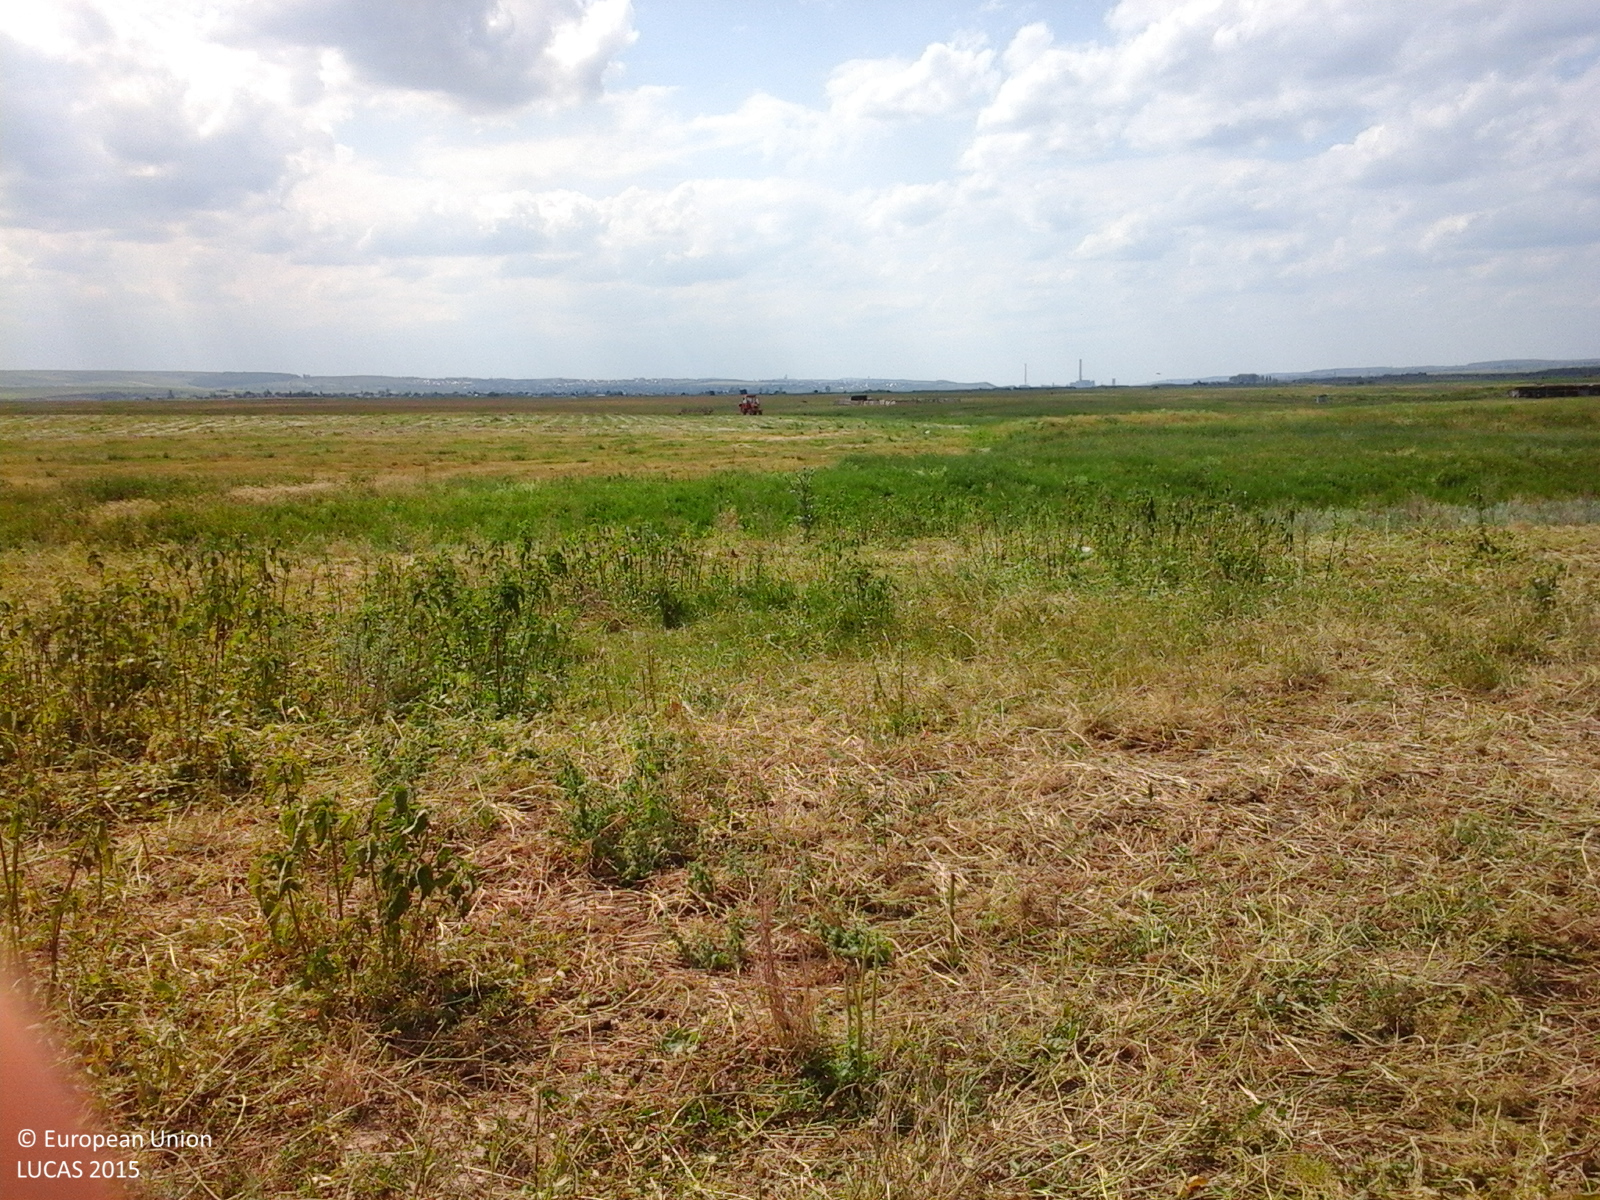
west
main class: Grassland
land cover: Spontaneously vegetated surfaces
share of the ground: > 75 %
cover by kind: herbaceous plants 100 %
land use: Agriculture (excluding fallow land and kitchen gardens)
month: June
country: RO
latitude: 47.6071
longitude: 26.4089
